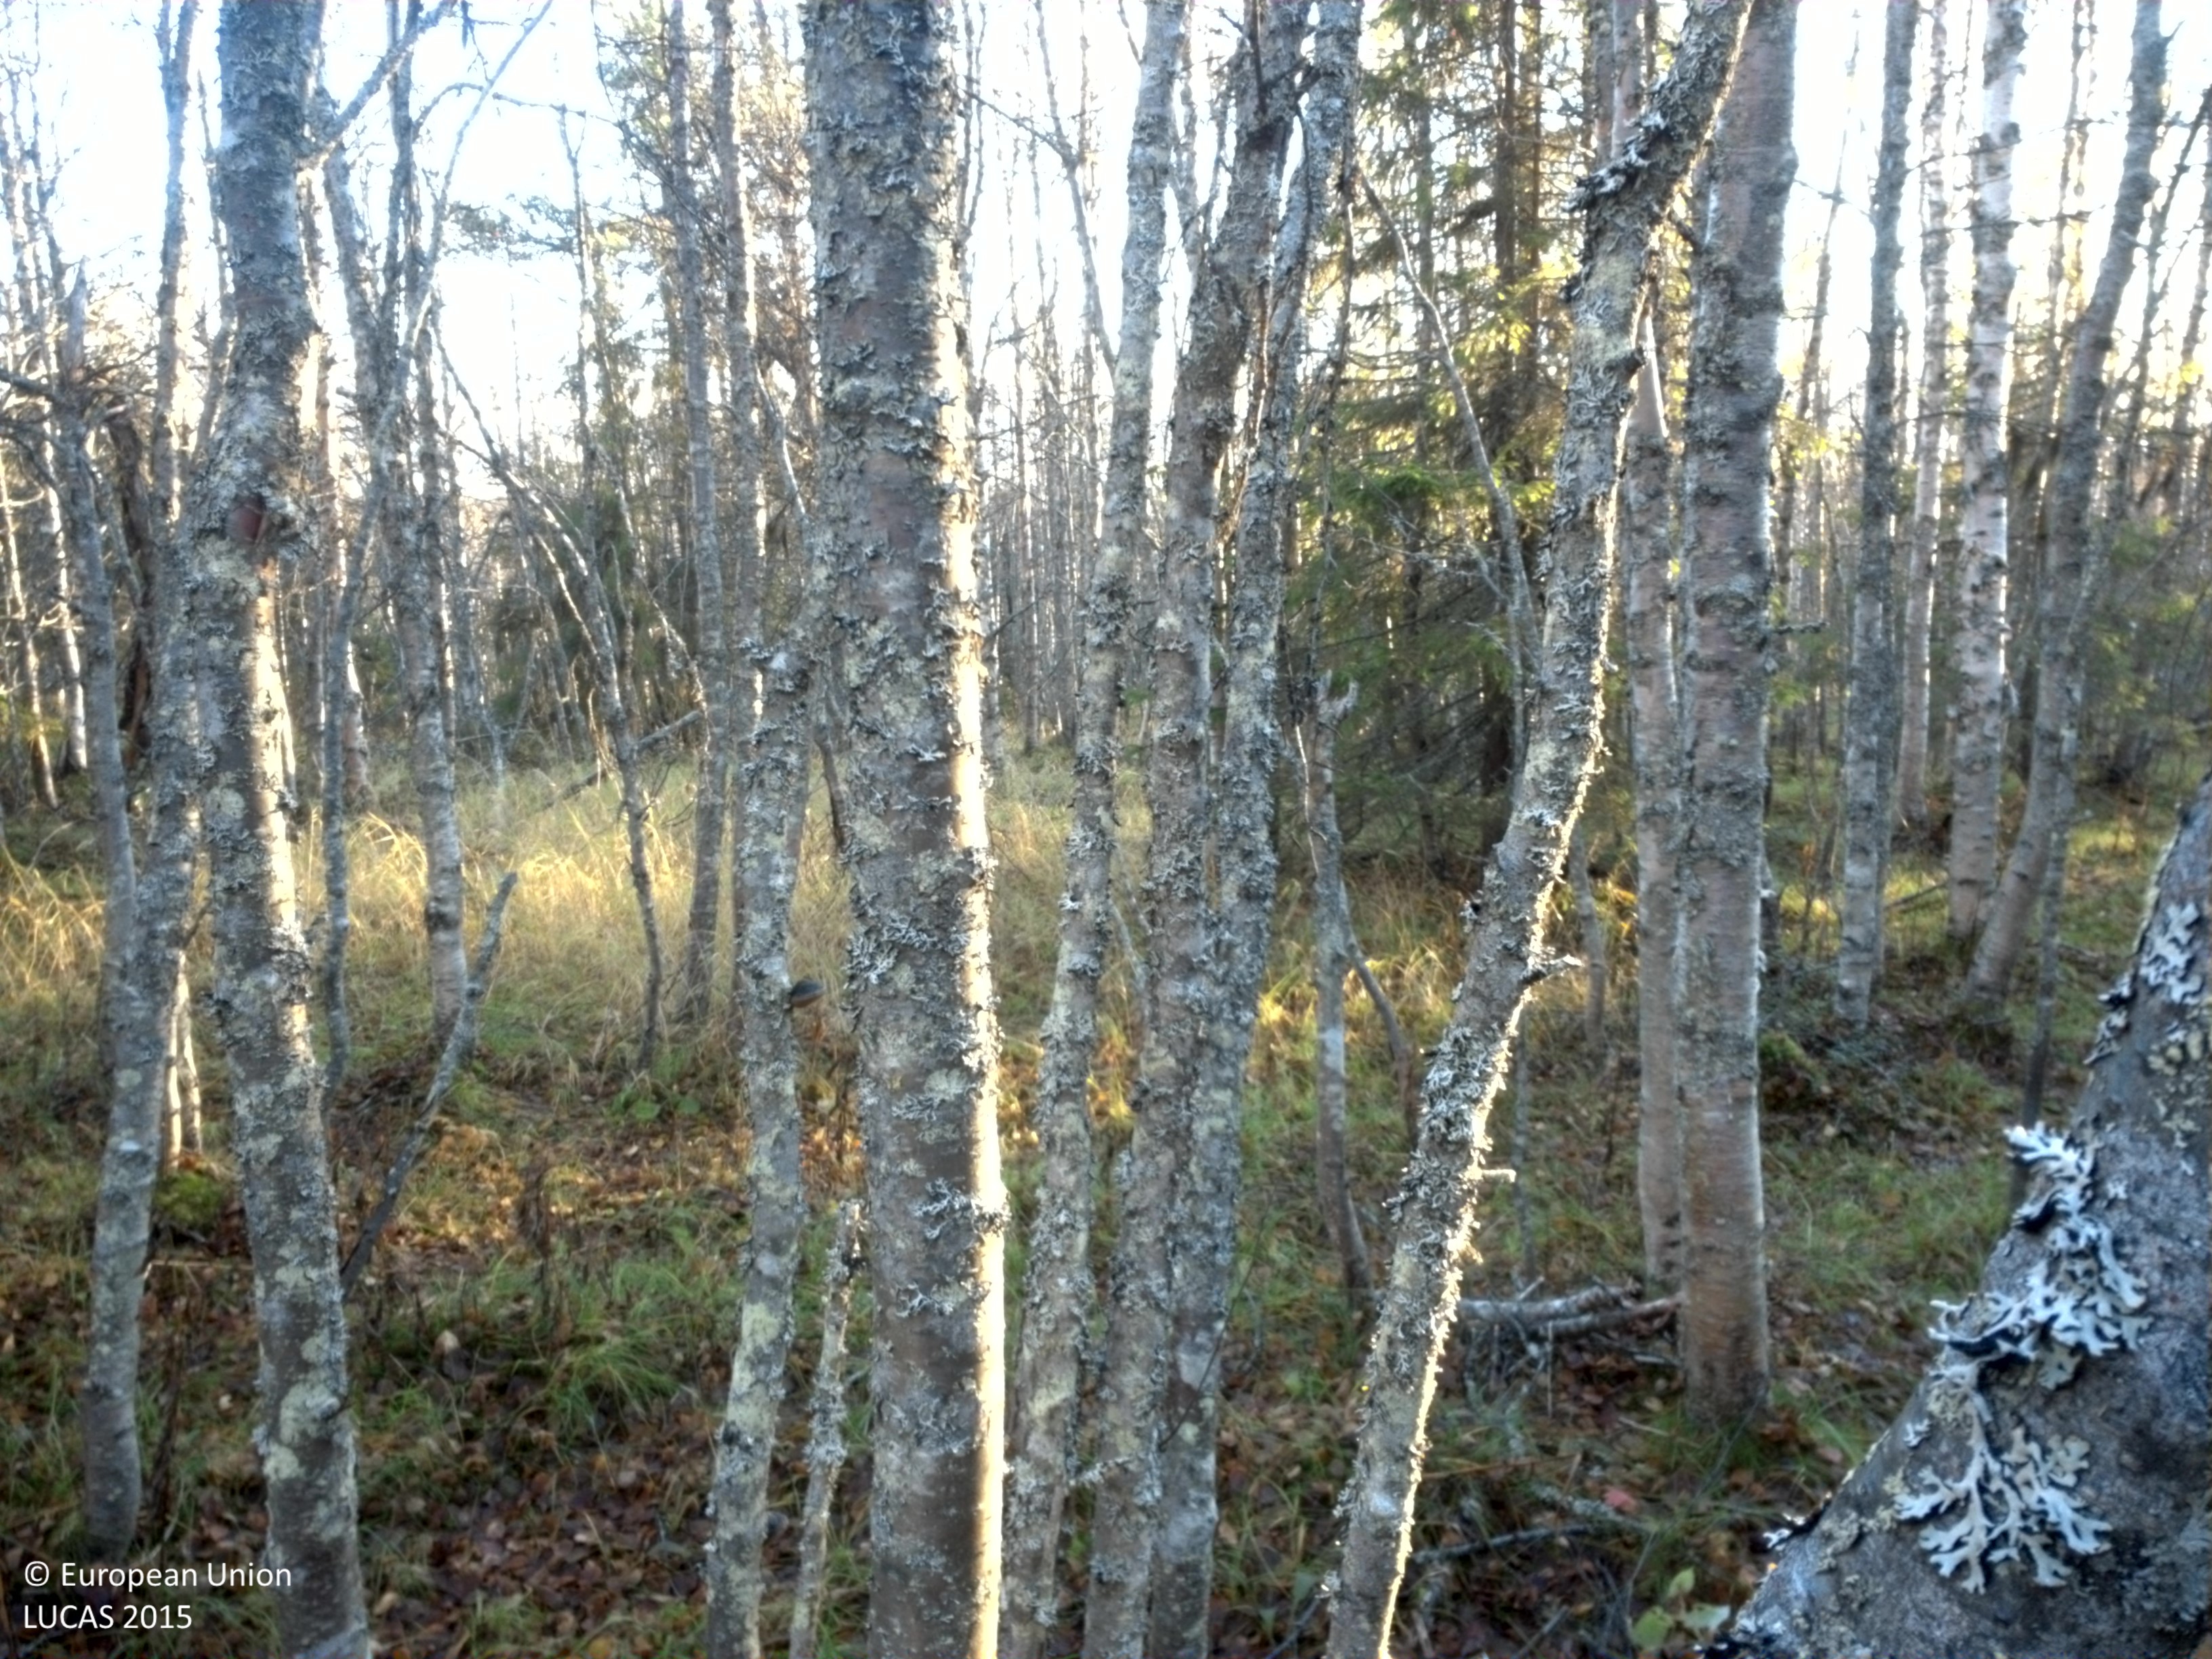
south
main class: Woodland
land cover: Broadleaved woodland
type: non-riverine alder, birch or aspen forest
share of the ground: 50 - 75 %
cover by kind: broadleaved forest trees 50 %, herbaceous plants 30 %, coniferous forest trees 10 %, shrubs 5 %, lichens and mosses 5 %
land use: Forestry
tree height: > 5 m
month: October
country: SE
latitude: 64.7347
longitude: 17.3781
